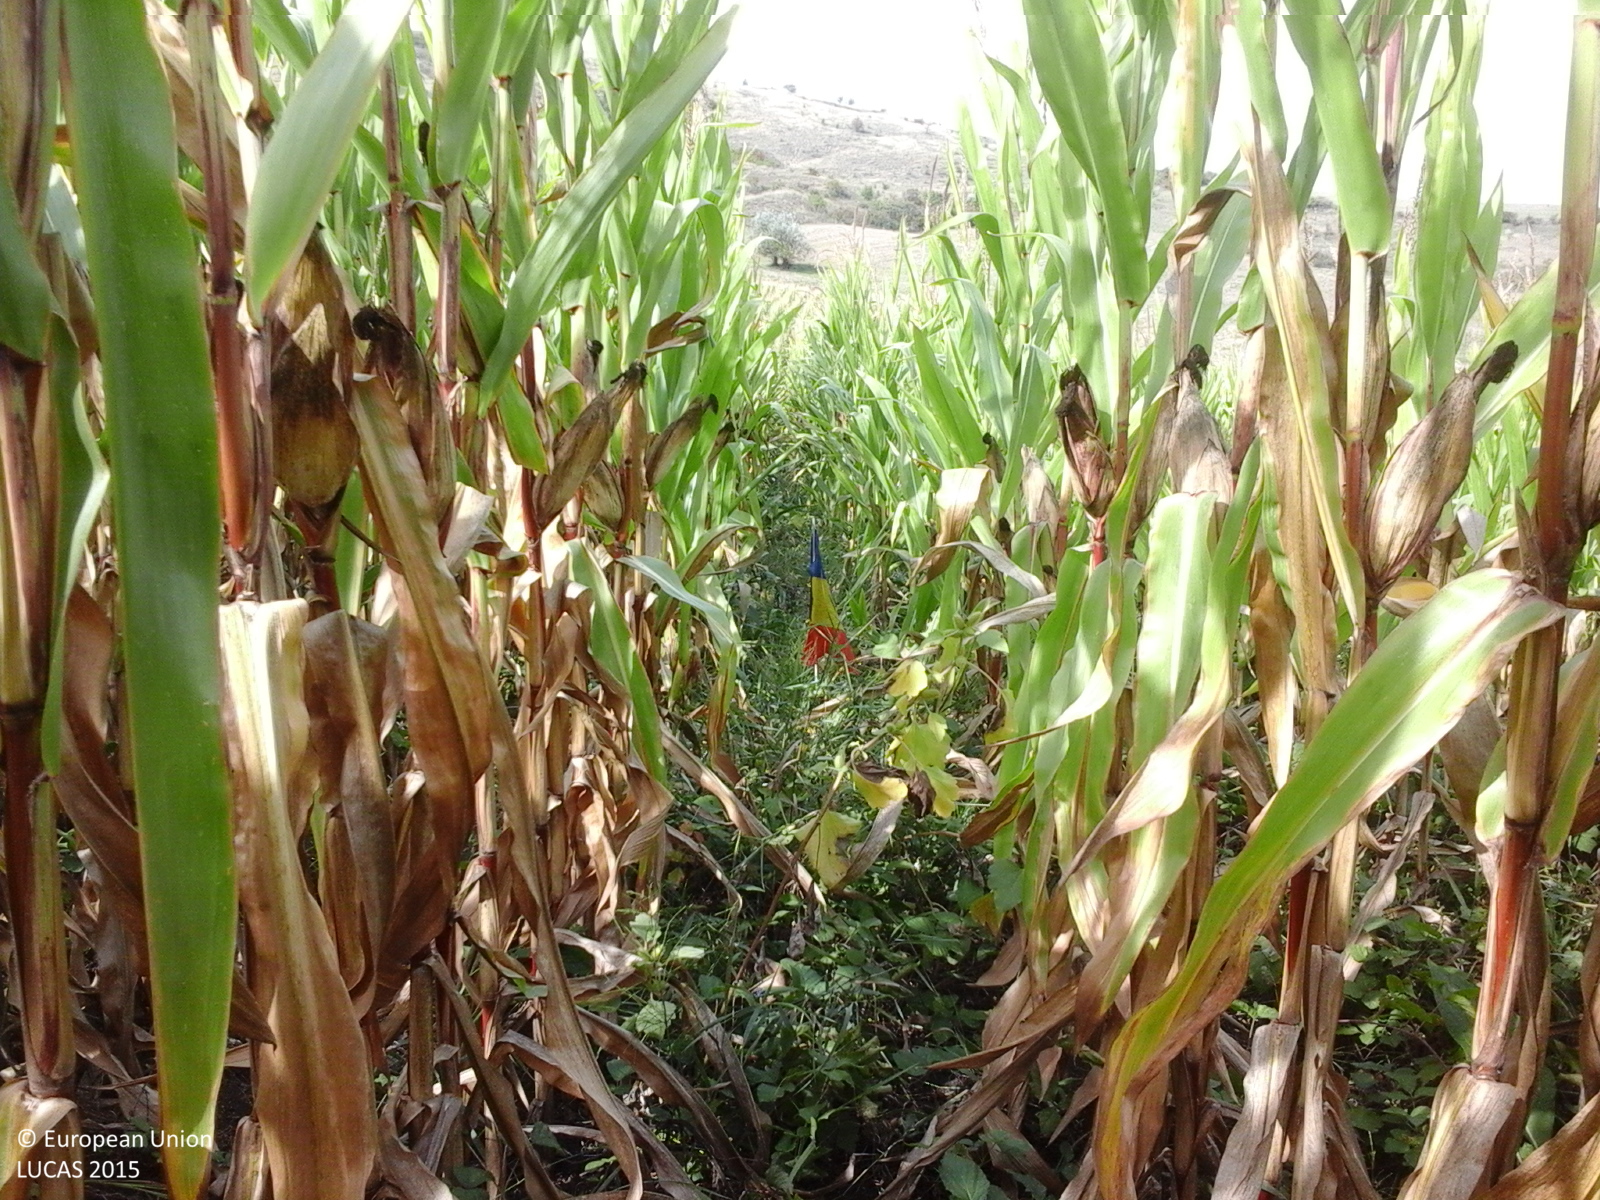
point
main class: Cropland
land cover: Maize
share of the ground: > 75 %
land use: Agriculture (excluding fallow land and kitchen gardens)
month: September
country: RO
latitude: 46.5893
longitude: 23.8972
